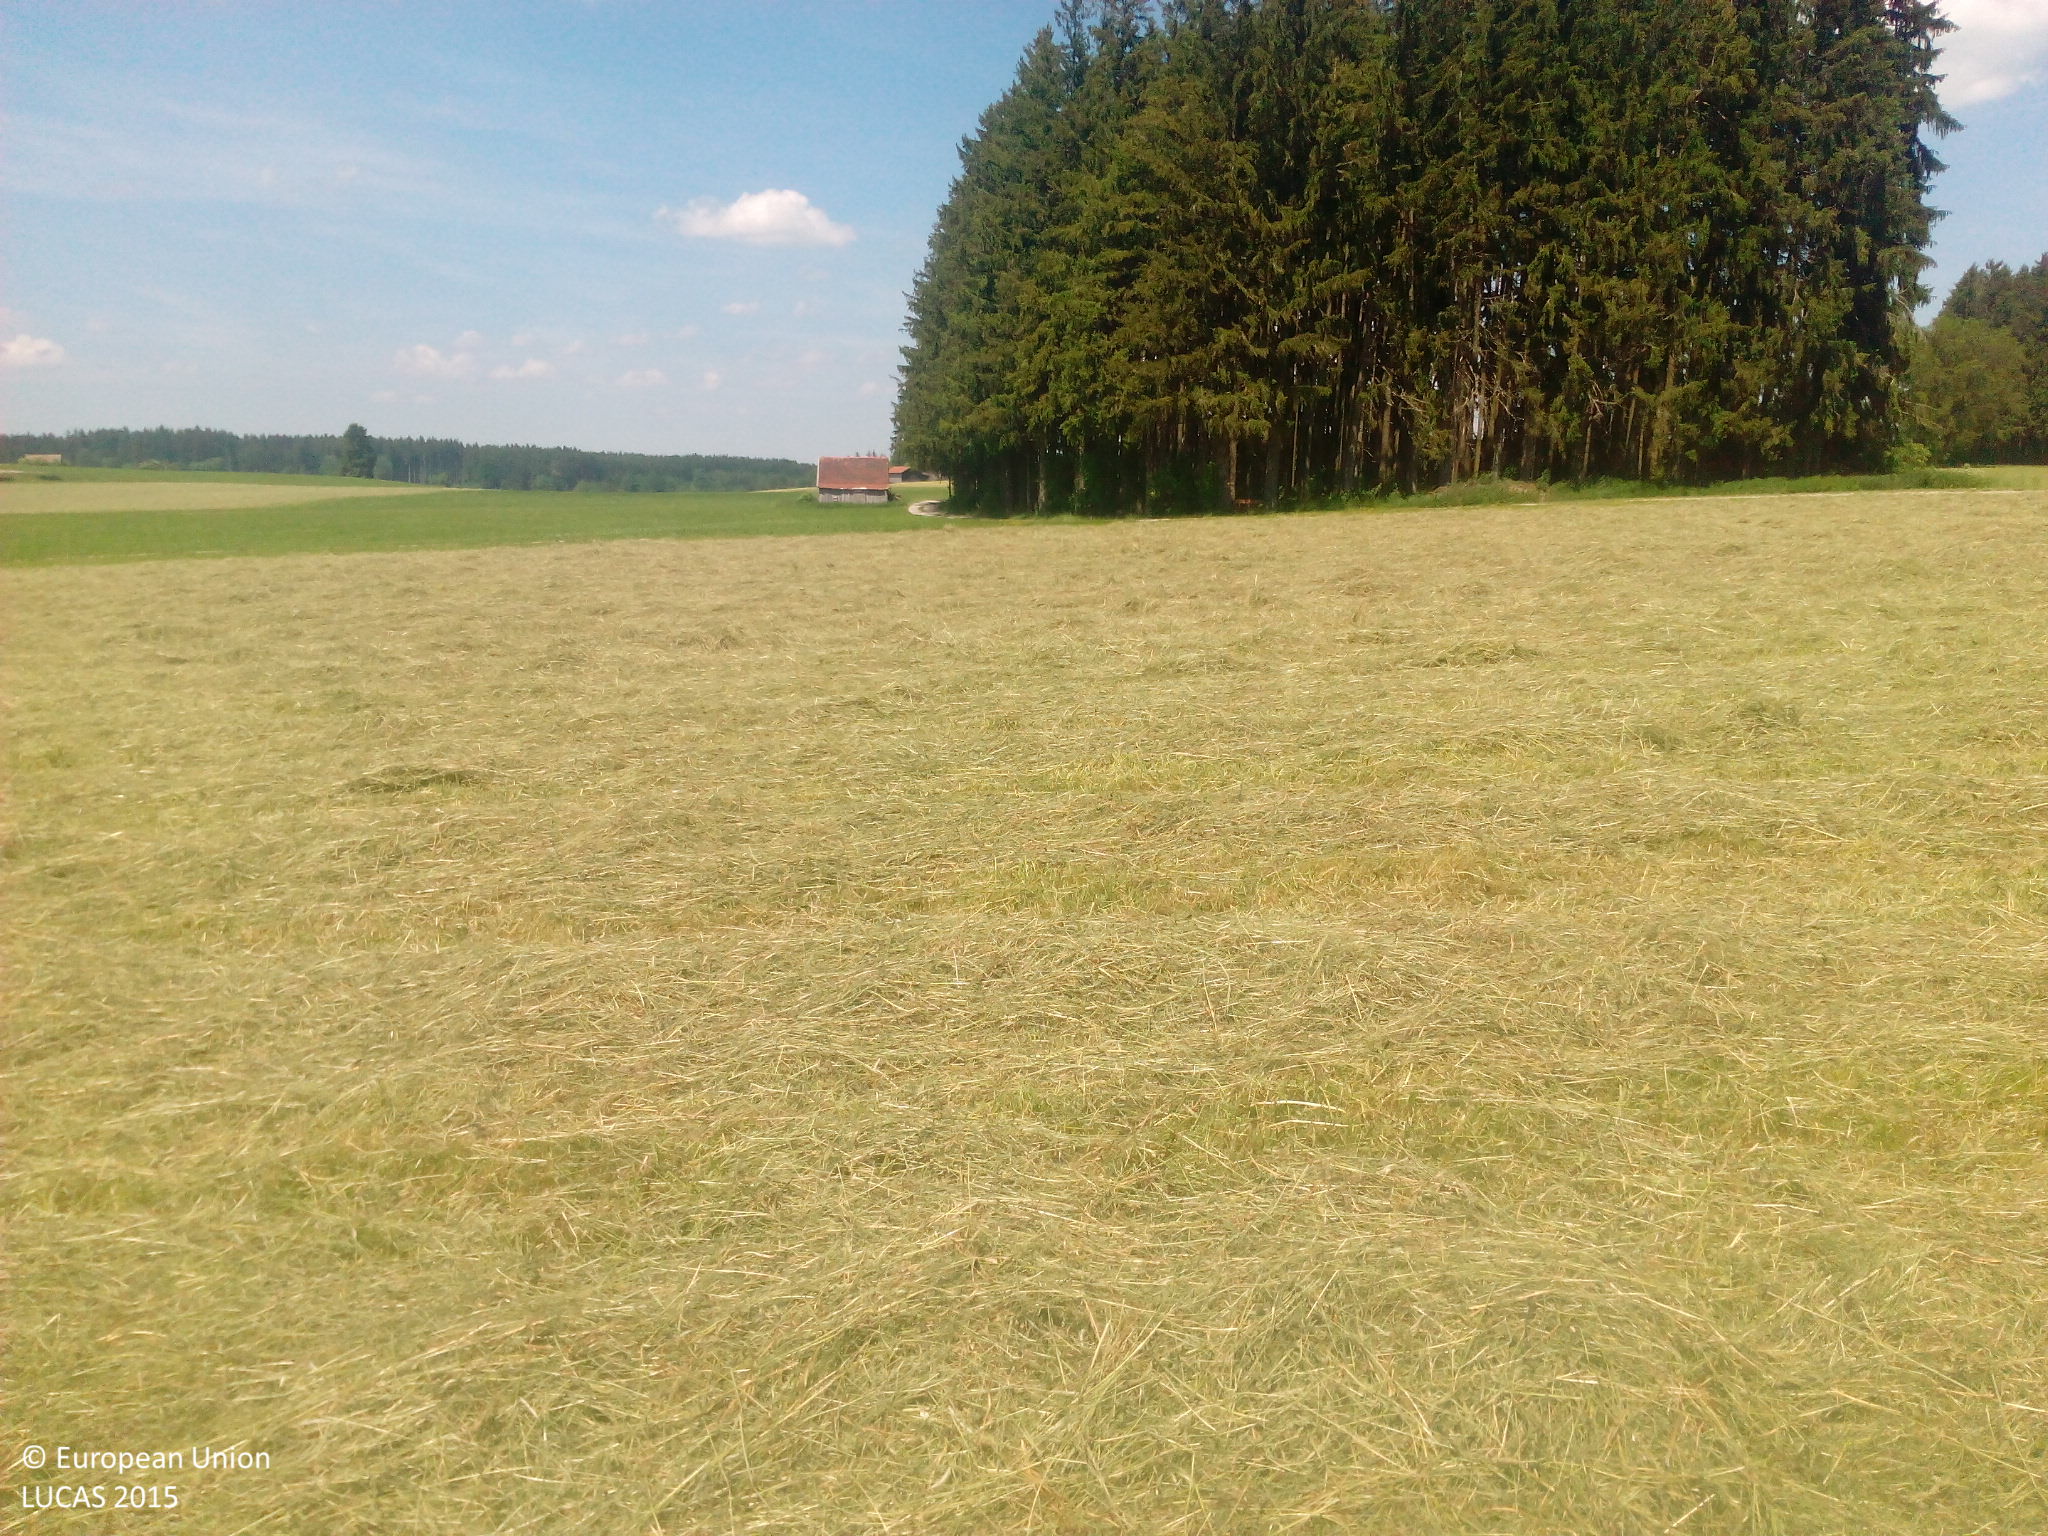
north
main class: Grassland
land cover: Grassland without tree/shrub cover
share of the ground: > 75 %
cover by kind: herbaceous plants 100 %
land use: Agriculture (excluding fallow land and kitchen gardens)
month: June
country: DE
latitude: 47.8624
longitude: 10.5209
